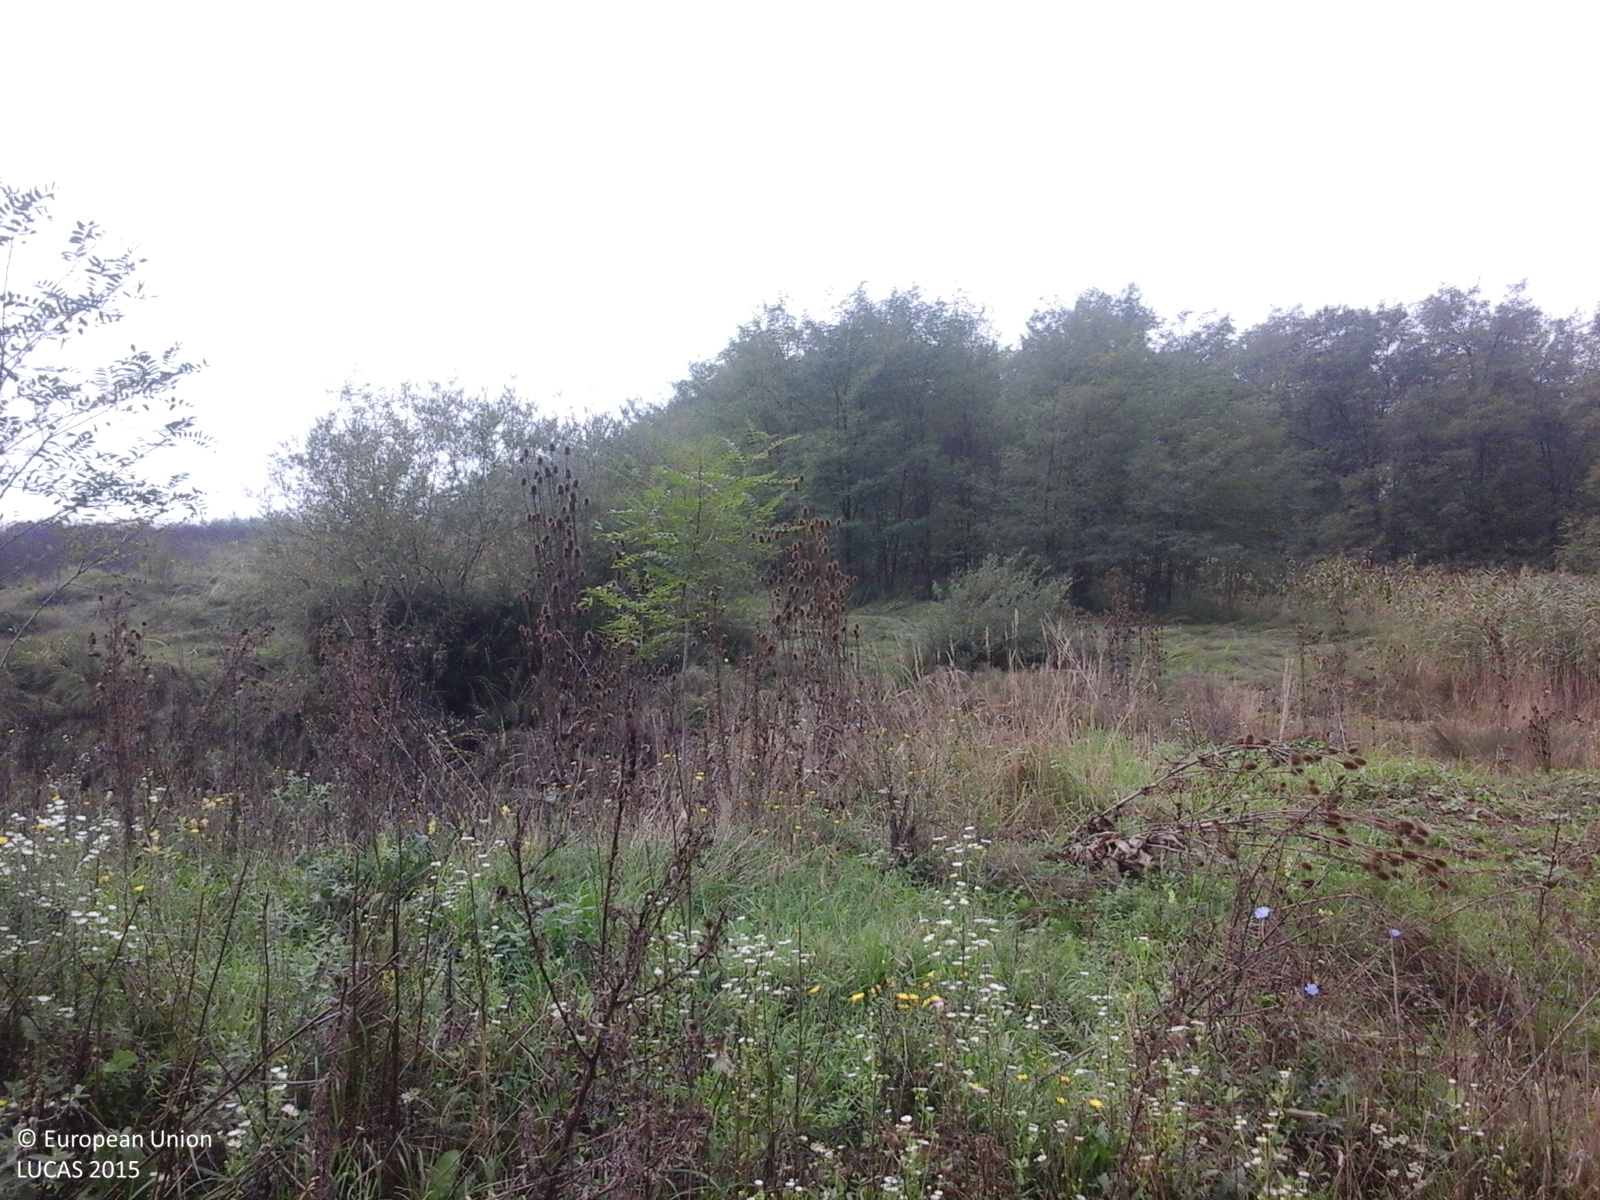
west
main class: Grassland
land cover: Spontaneously vegetated surfaces
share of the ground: > 75 %
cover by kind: herbaceous plants 100 %
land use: Fallow land
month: September
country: RO
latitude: 44.8531
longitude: 22.9156
